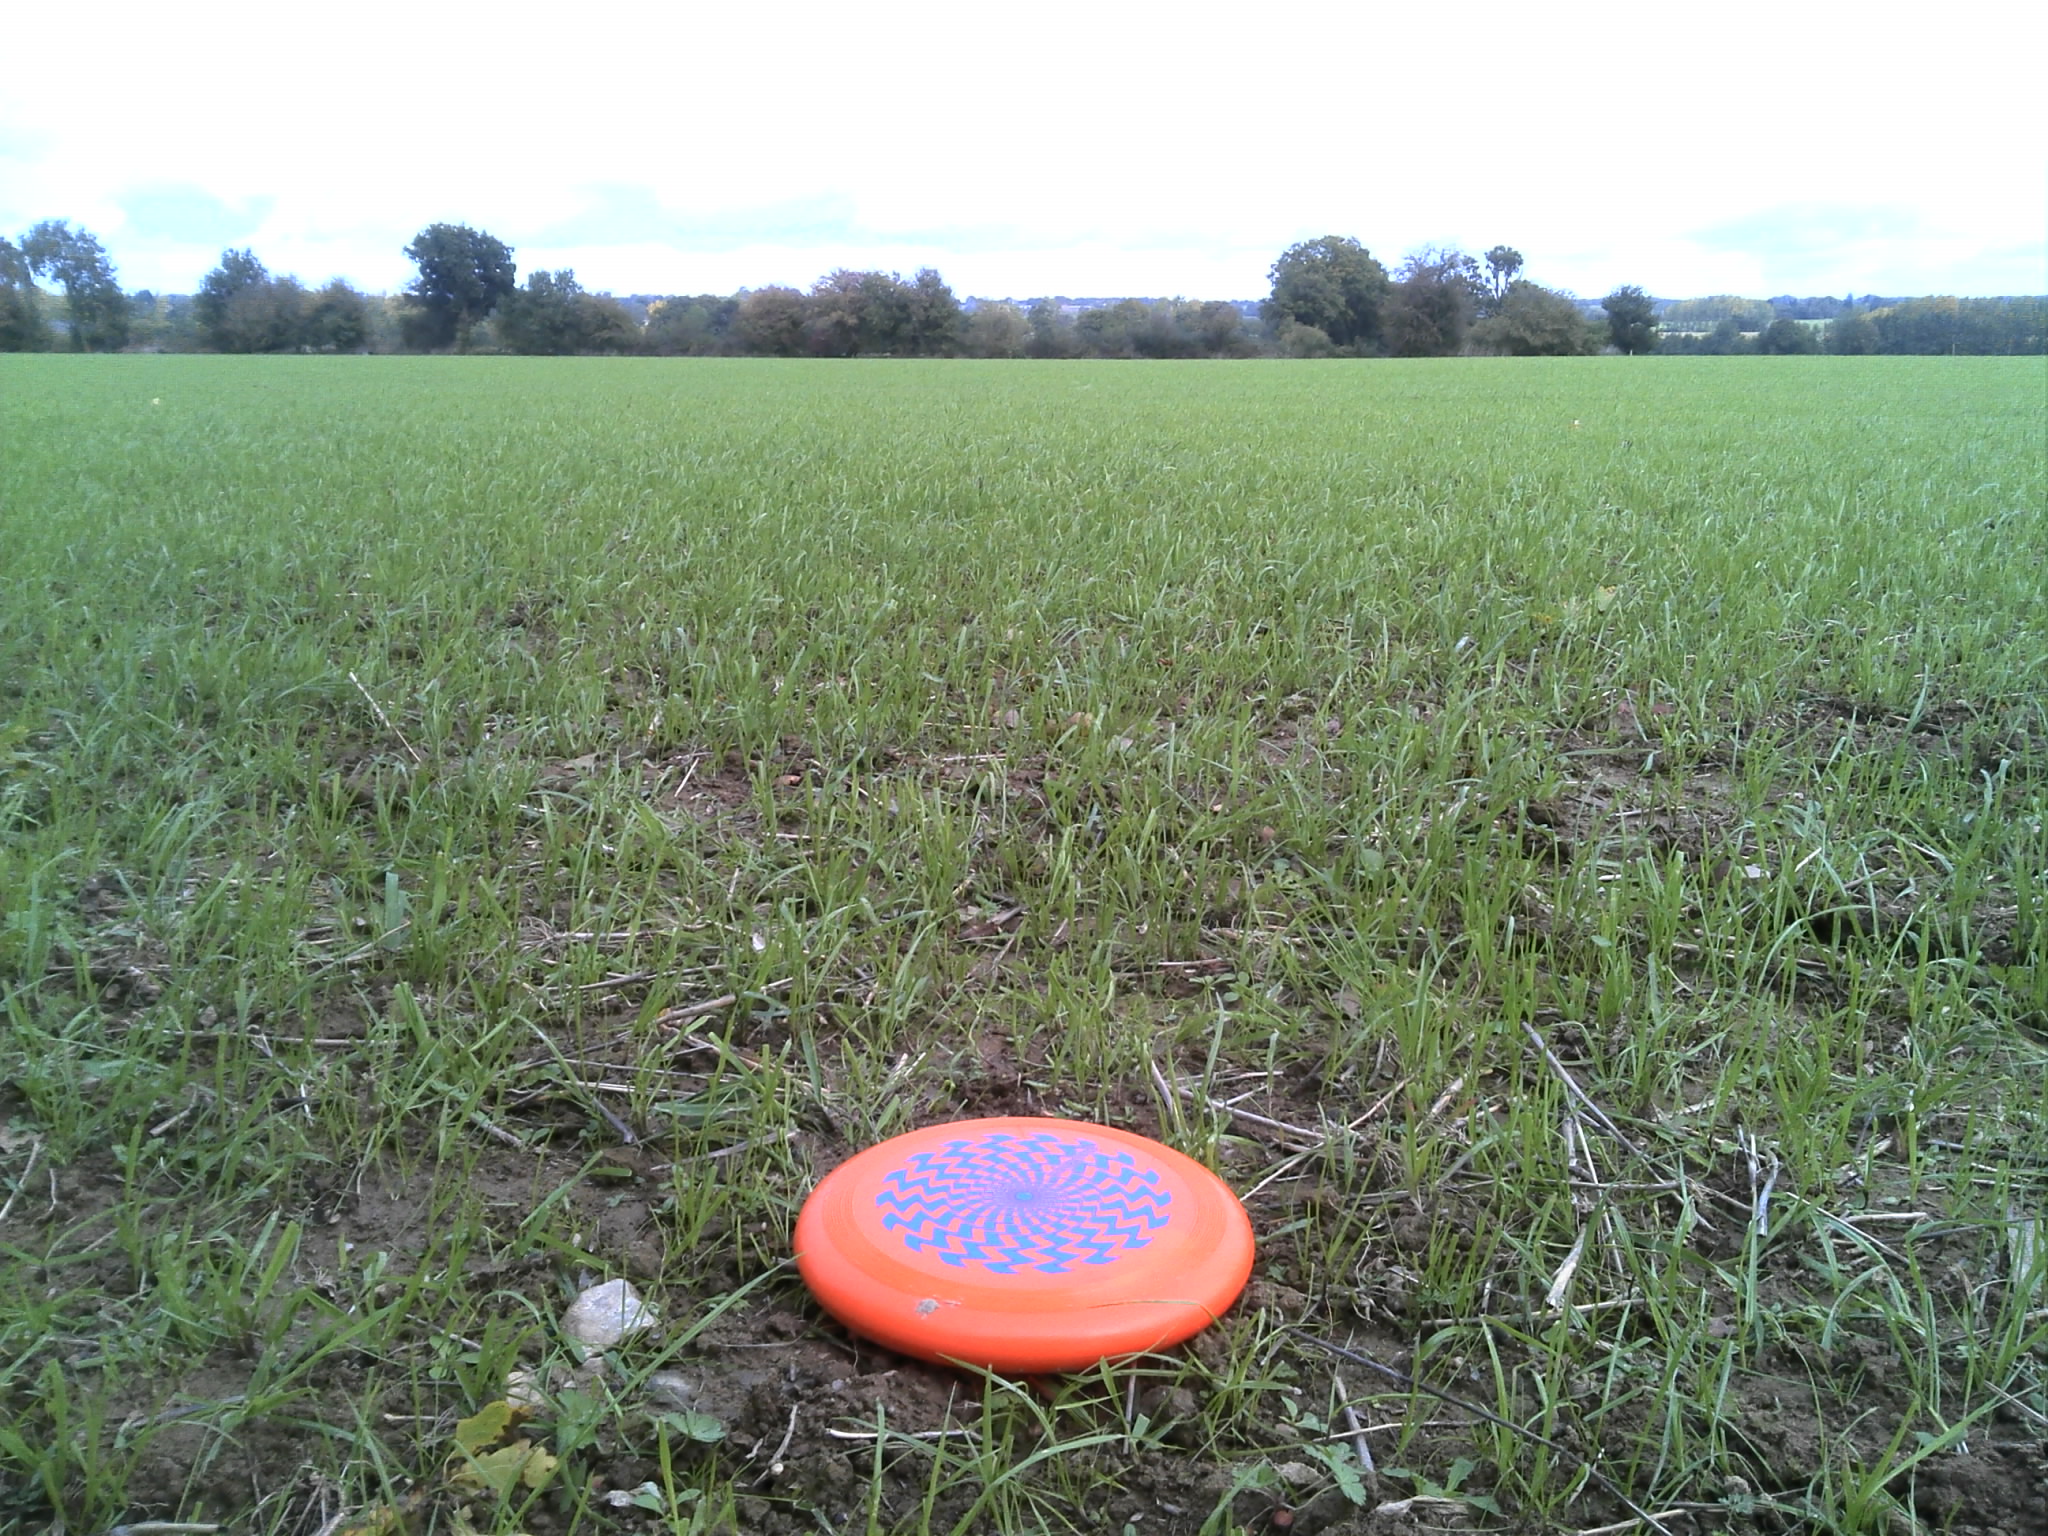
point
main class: Cropland
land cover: Temporary grasslands
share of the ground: > 75 %
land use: Agriculture (excluding fallow land and kitchen gardens)
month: October
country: FR
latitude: 47.6989
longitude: -1.0854
